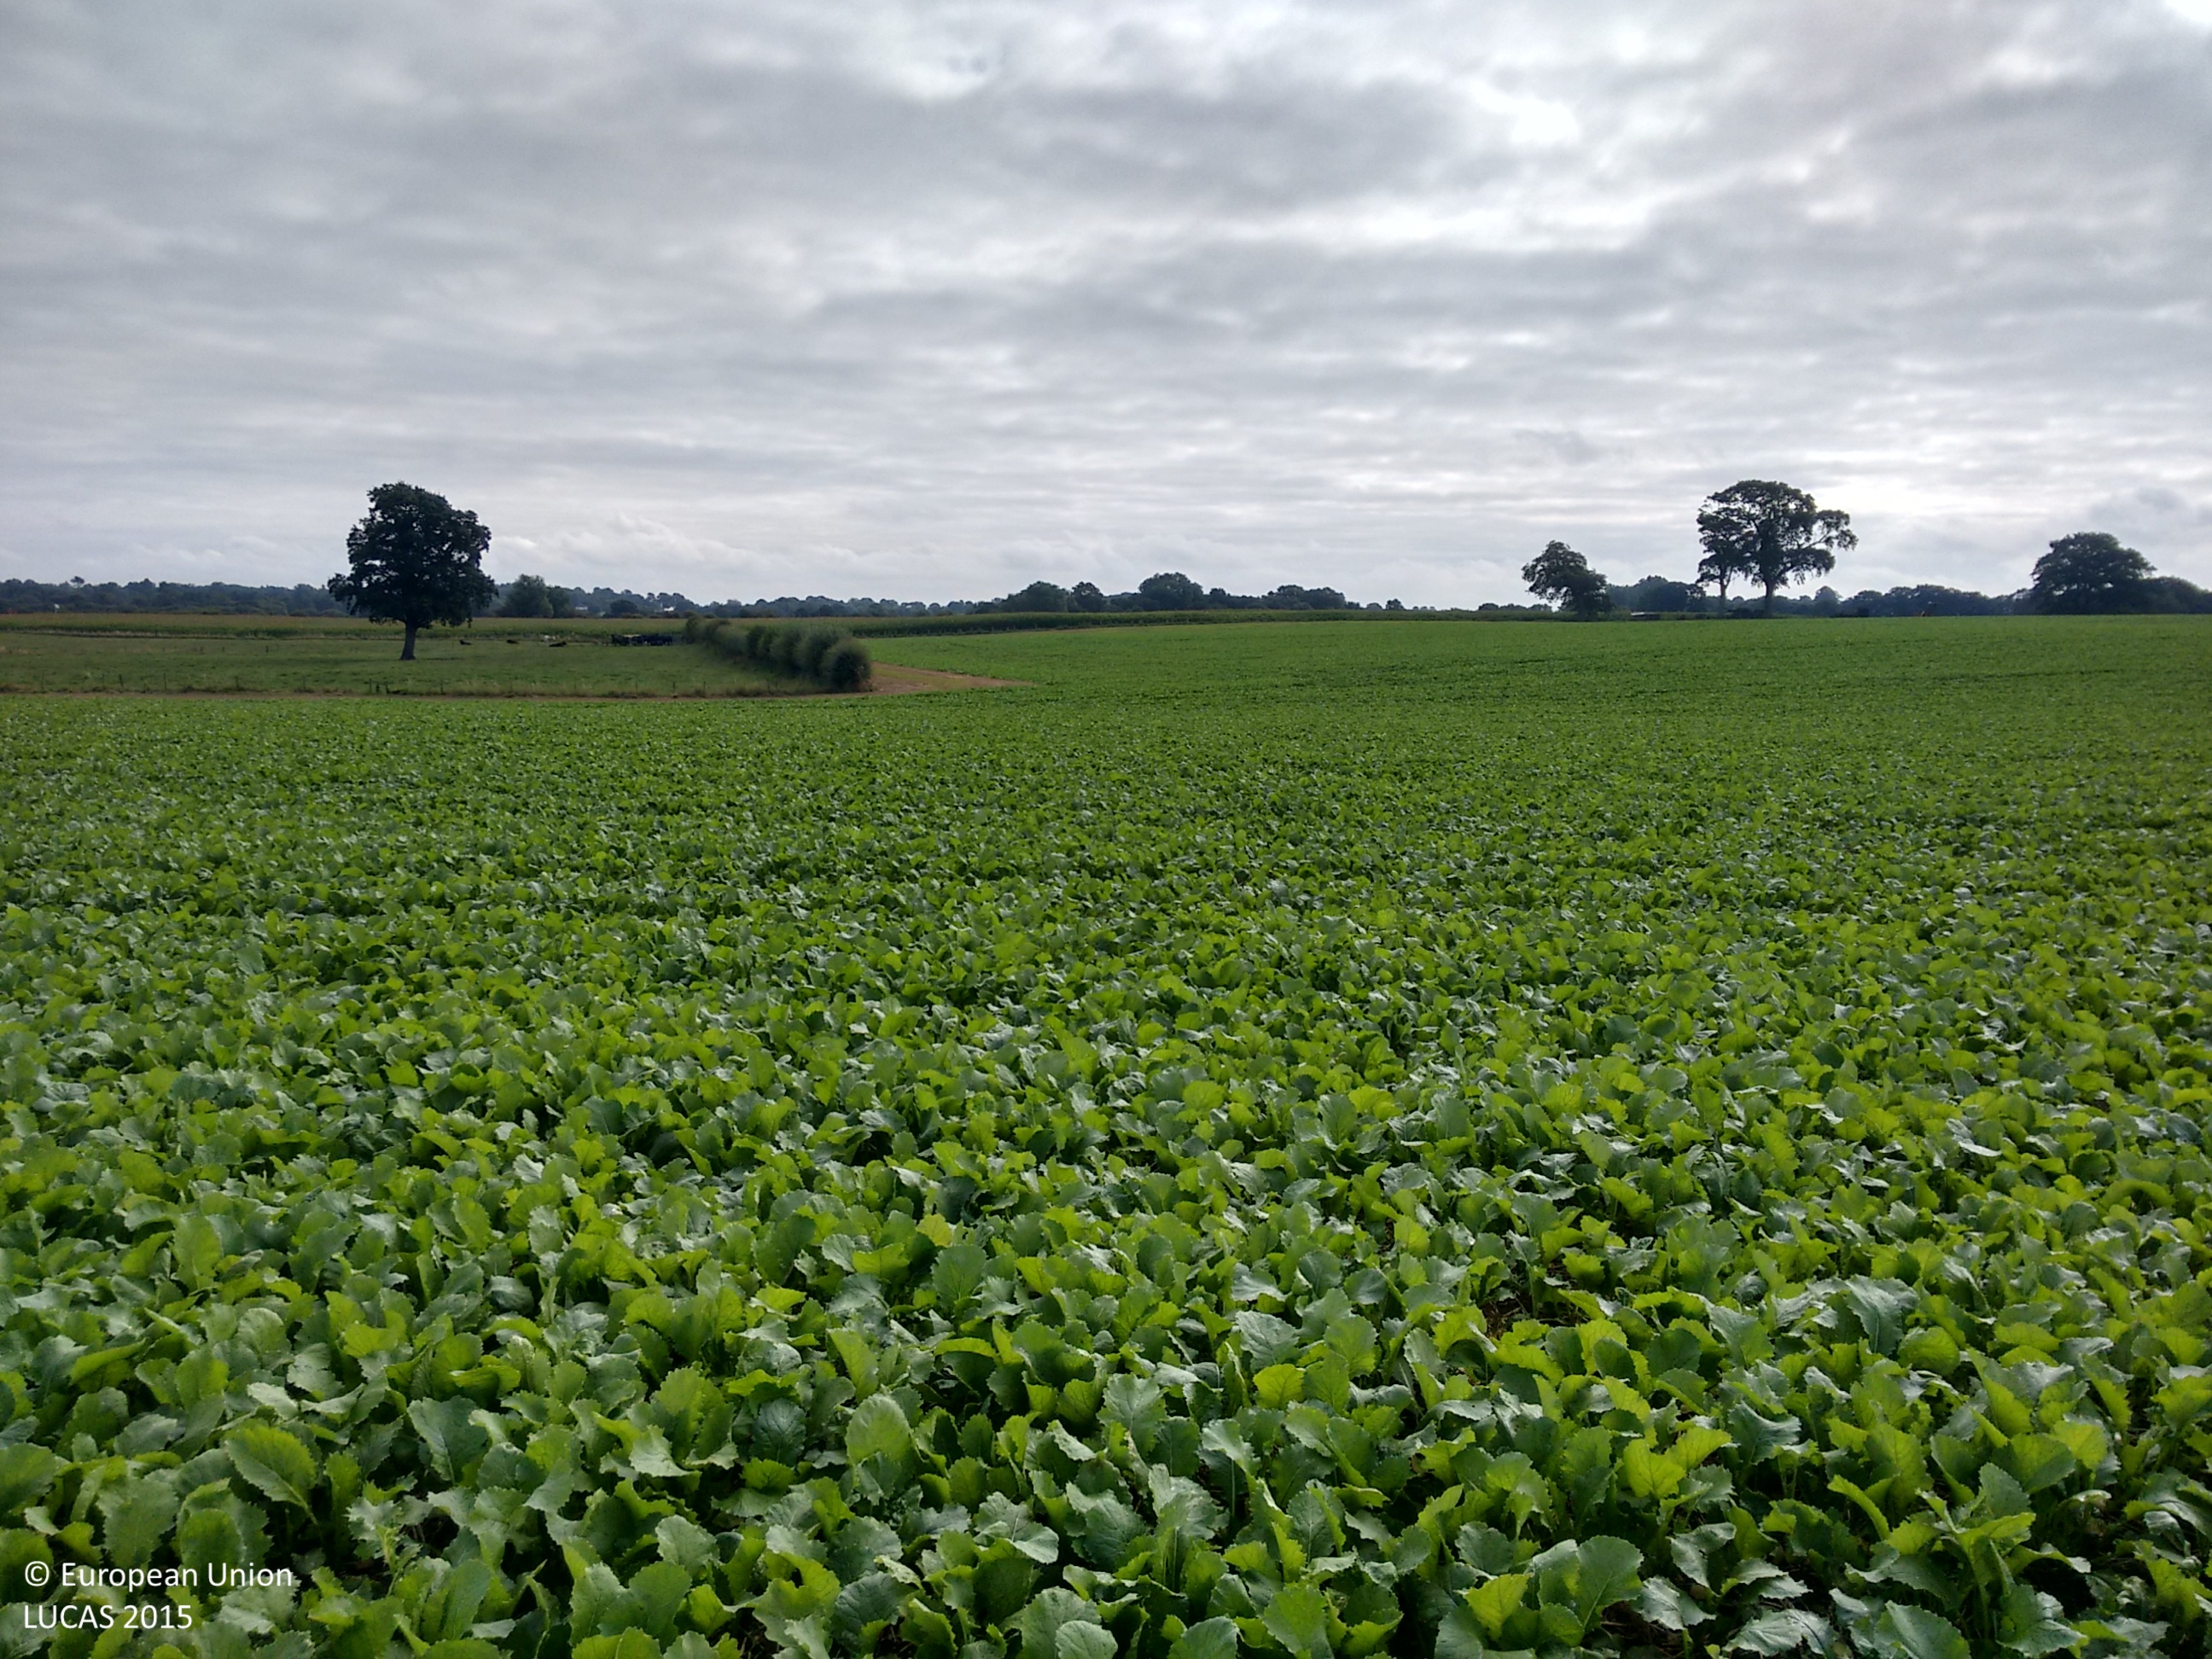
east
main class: Cropland
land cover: Sugar beet
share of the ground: > 75 %
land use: Agriculture (excluding fallow land and kitchen gardens)
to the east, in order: Sugar beet; Barley; Grass margins; Fences
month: September
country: GB
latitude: 52.8456
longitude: -2.9769
